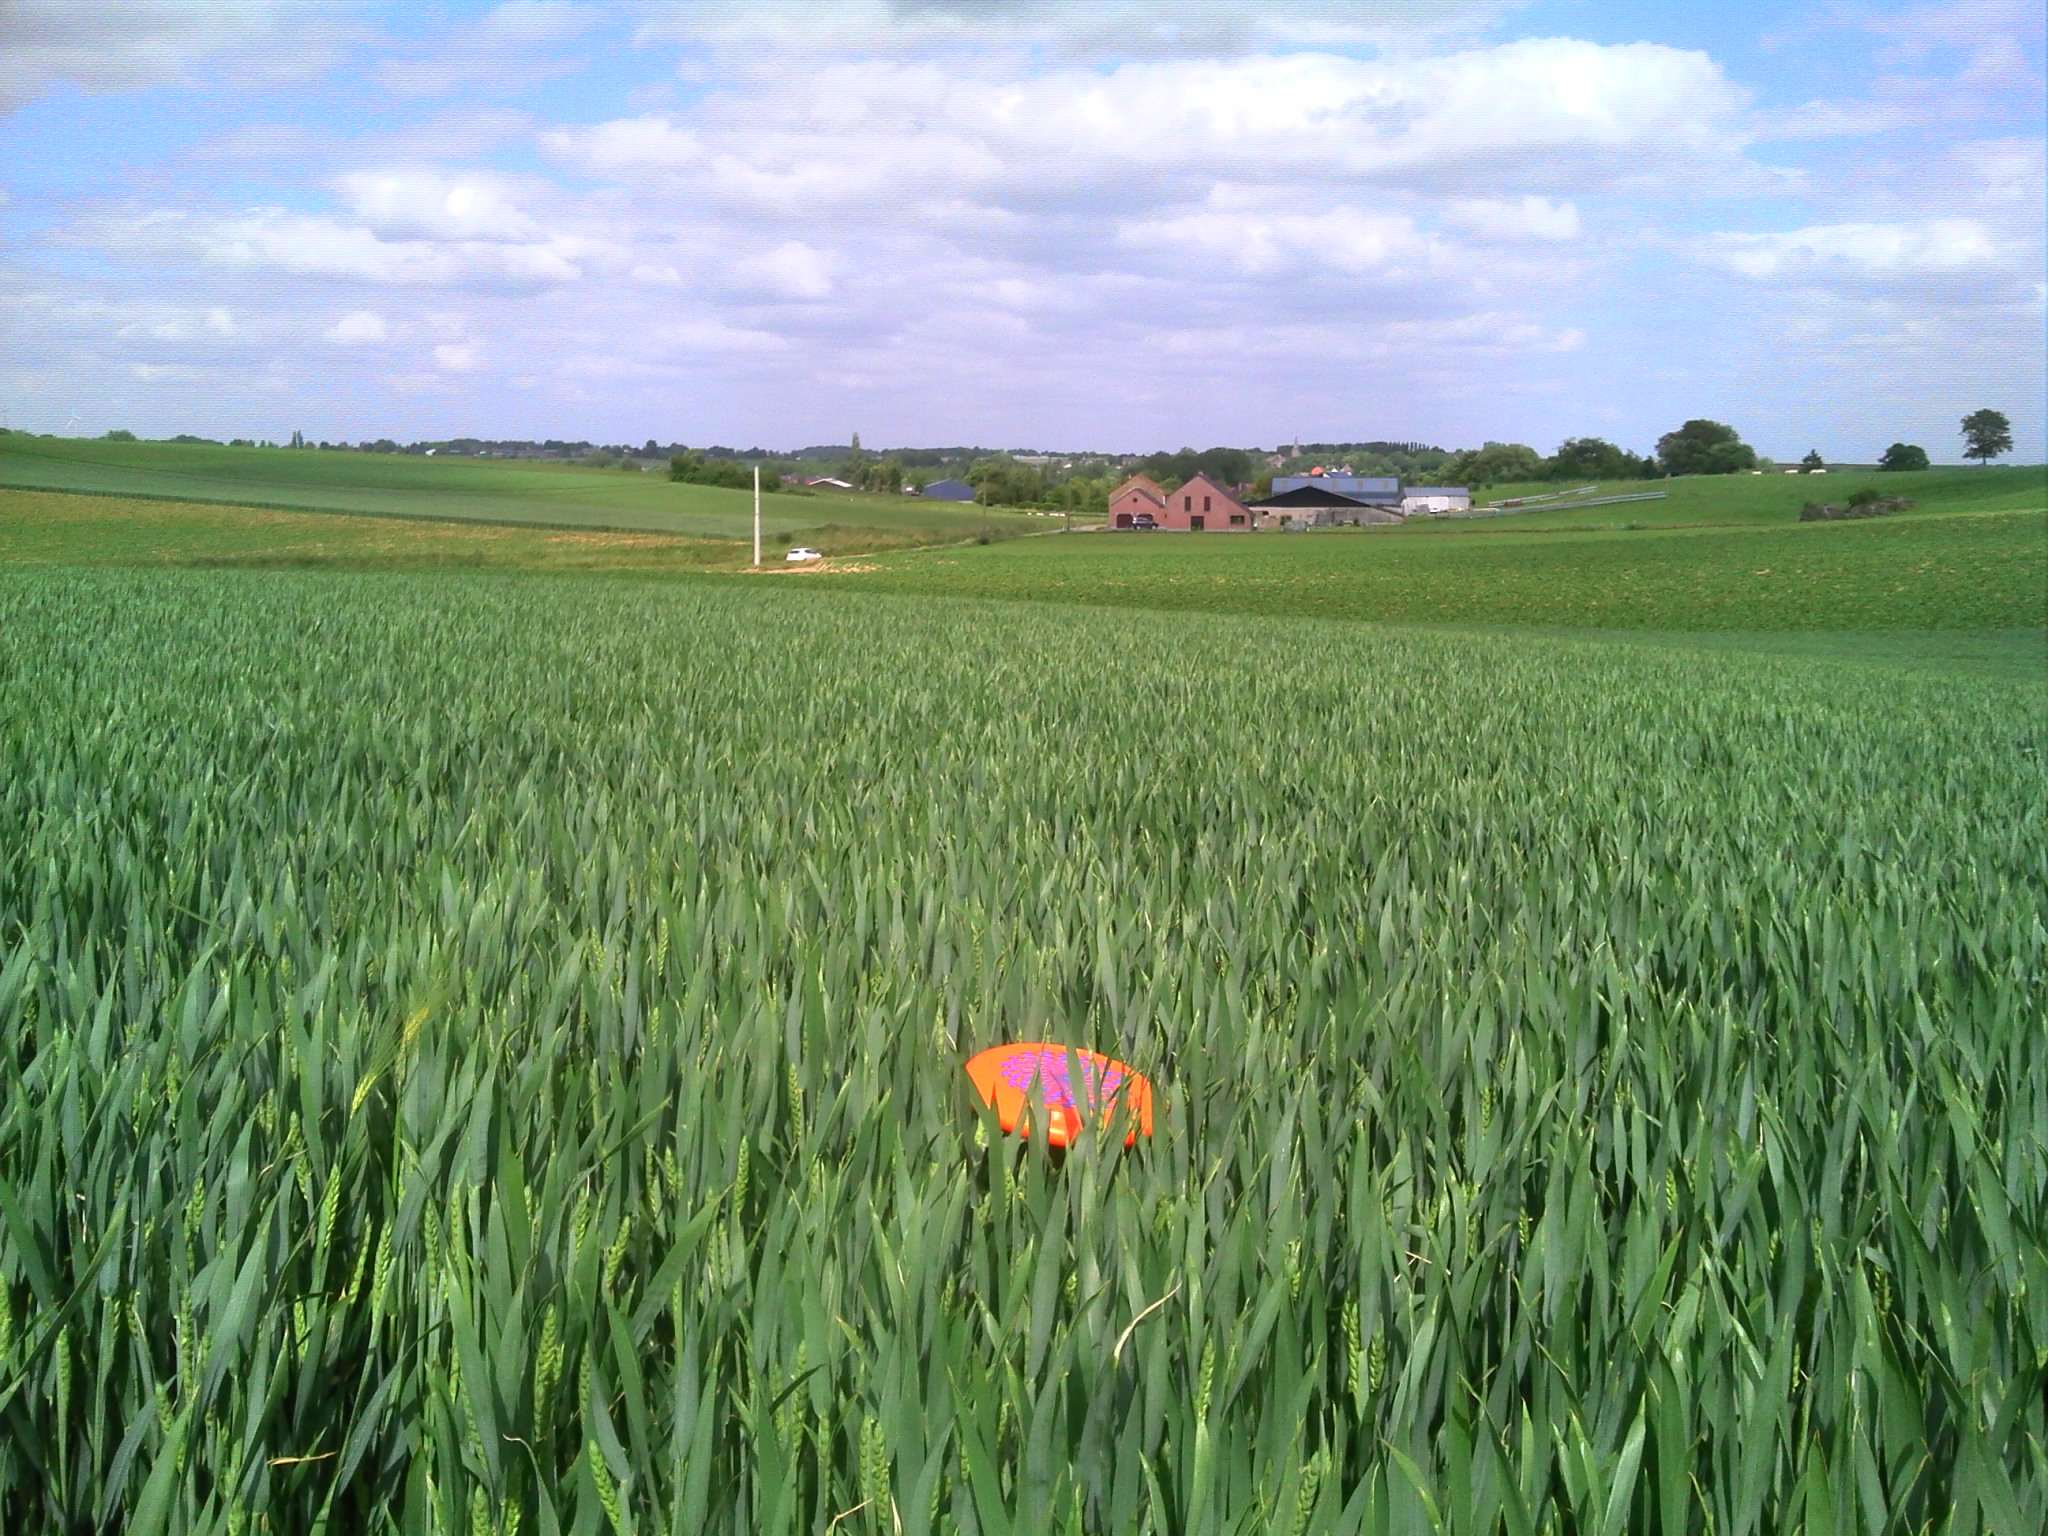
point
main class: Cropland
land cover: Common wheat
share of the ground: > 75 %
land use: Agriculture (excluding fallow land and kitchen gardens)
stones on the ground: < 10 %
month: June
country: BE
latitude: 50.5067
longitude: 4.5957
